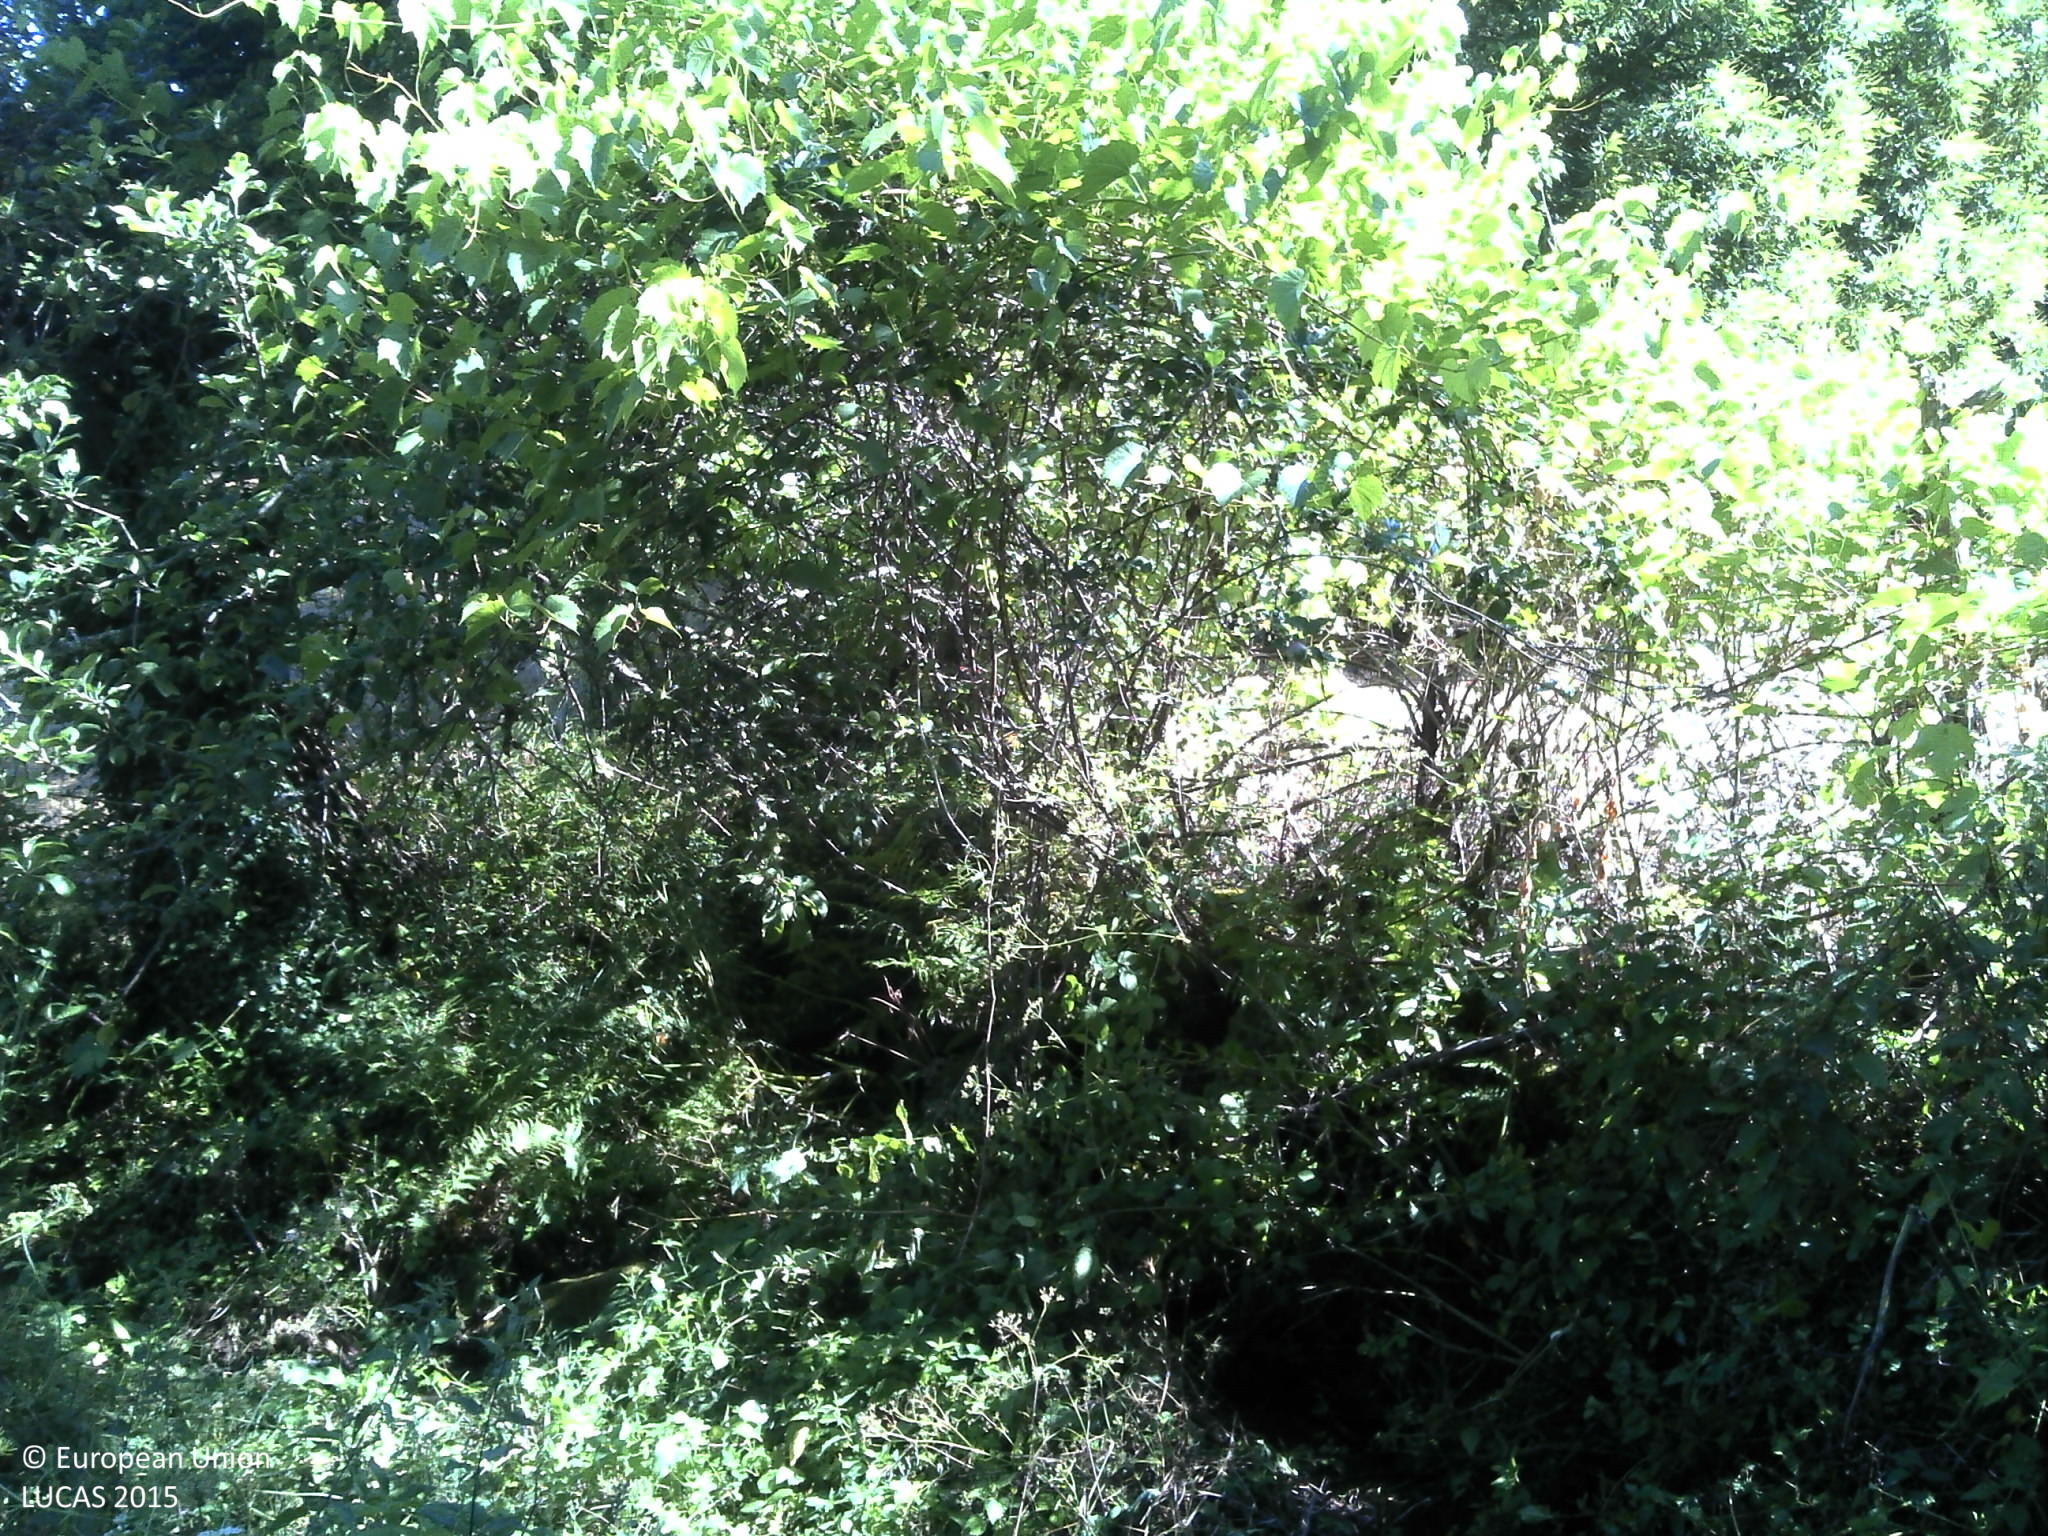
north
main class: Shrubland
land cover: Shrubland without tree cover
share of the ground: > 75 %
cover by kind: shrubs 90 %, unconsolidated bare surface 10 %
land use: Semi-natural and natural areas not in use
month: June
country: PT
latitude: 40.8755
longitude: -8.0132
